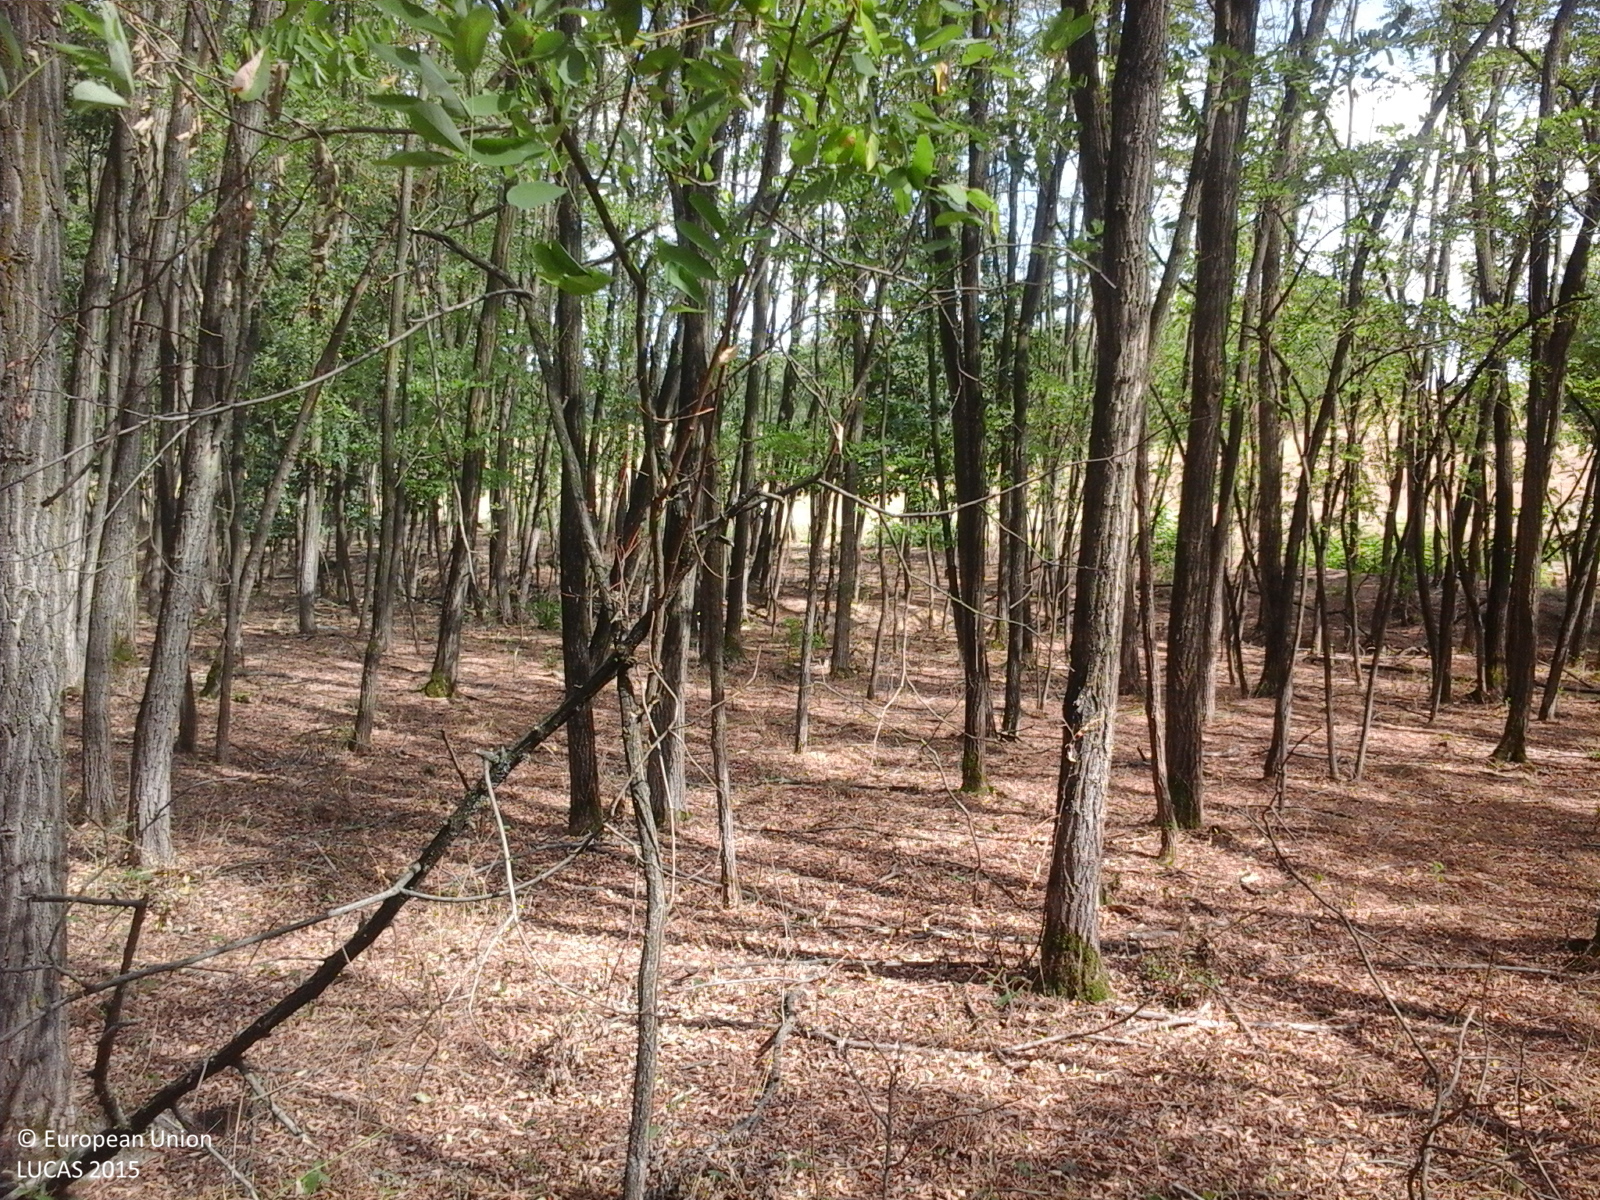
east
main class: Woodland
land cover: Broadleaved woodland
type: exotic forest
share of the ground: > 75 %
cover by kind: broadleaved forest trees 100 %
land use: Forestry
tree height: > 5 m
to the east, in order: Broadleaved woodland; Ditches and canals; Spontaneously vegetated surfaces; Tracks; Grassland without tree/shrub cover; Electric lines; Grassland without tree/shrub cover
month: September
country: RO
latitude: 47.6397
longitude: 22.9360
